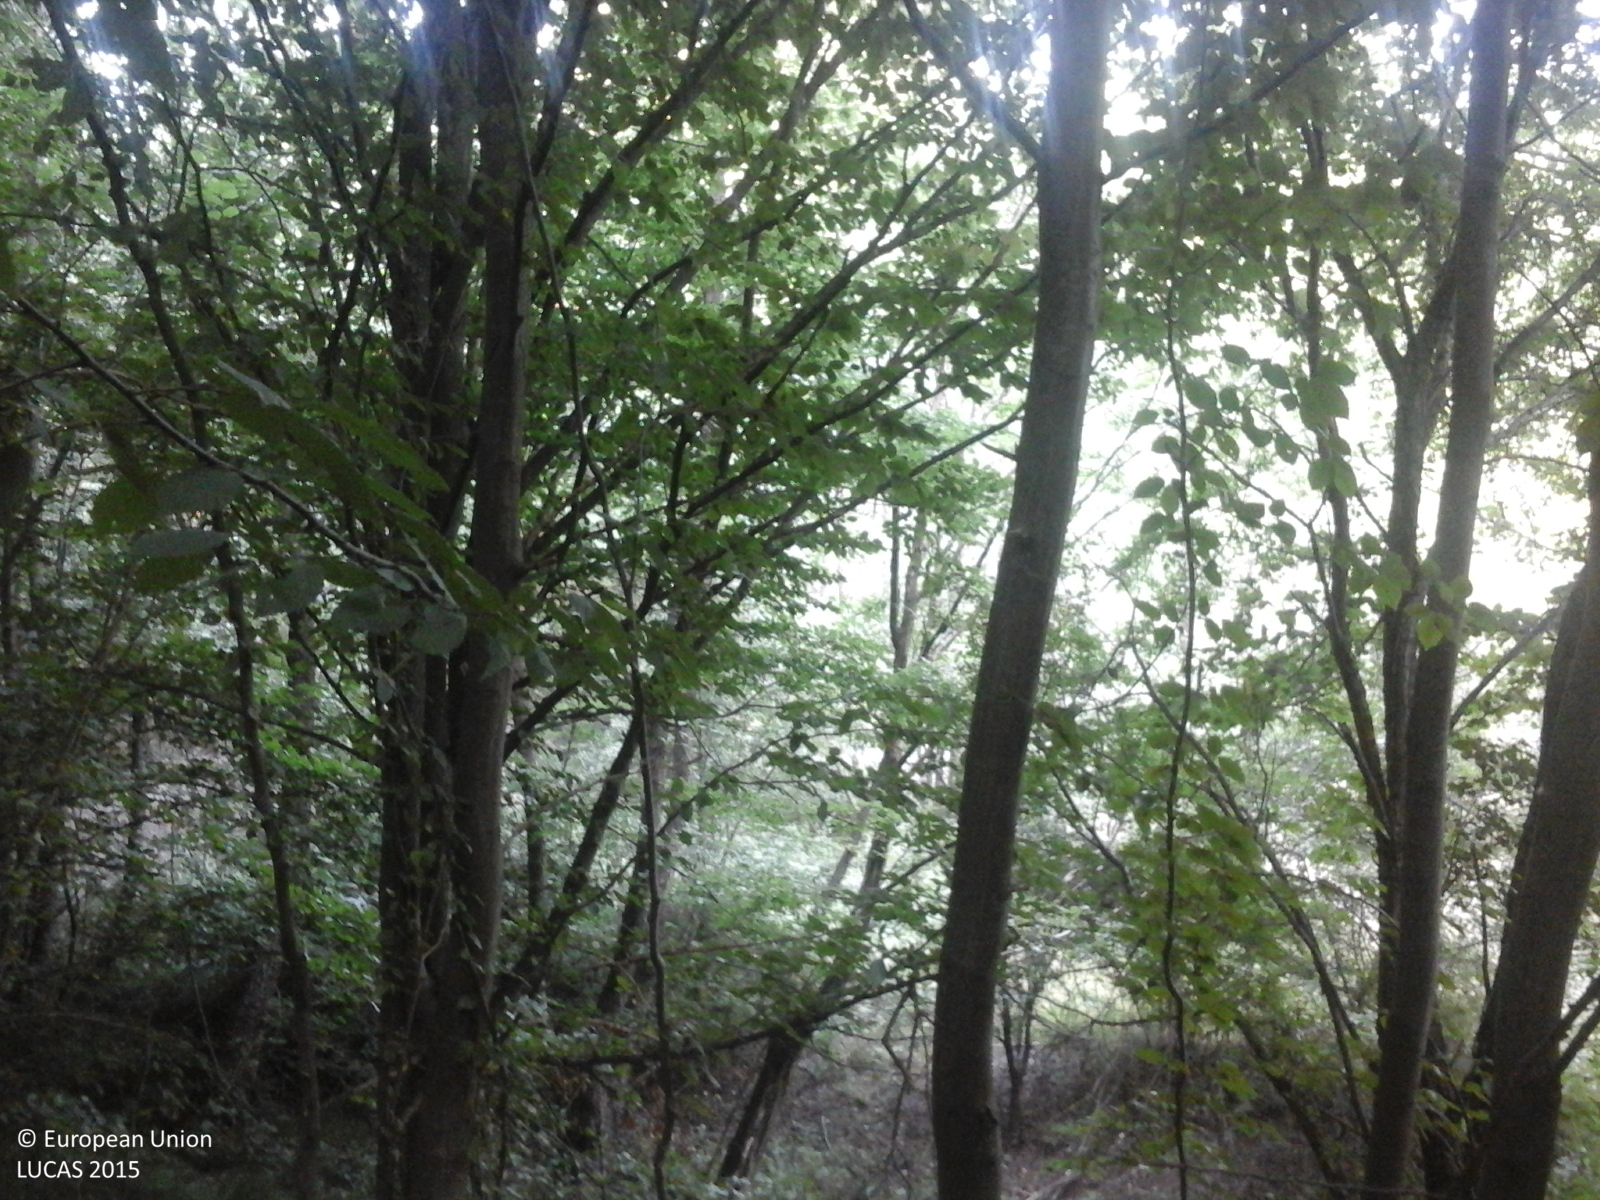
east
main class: Woodland
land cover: Broadleaved woodland
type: beech forest
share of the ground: > 75 %
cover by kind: broadleaved forest trees 100 %
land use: Forestry
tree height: > 5 m
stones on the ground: 10 - 25 %
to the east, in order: Broadleaved woodland; Spontaneously vegetated surfaces; Artificial constructions; Spontaneously vegetated surfaces; Broadleaved woodland; Grassland without tree/shrub cover; Broadleaved woodland
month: July
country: RO
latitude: 45.0584
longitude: 24.5406
